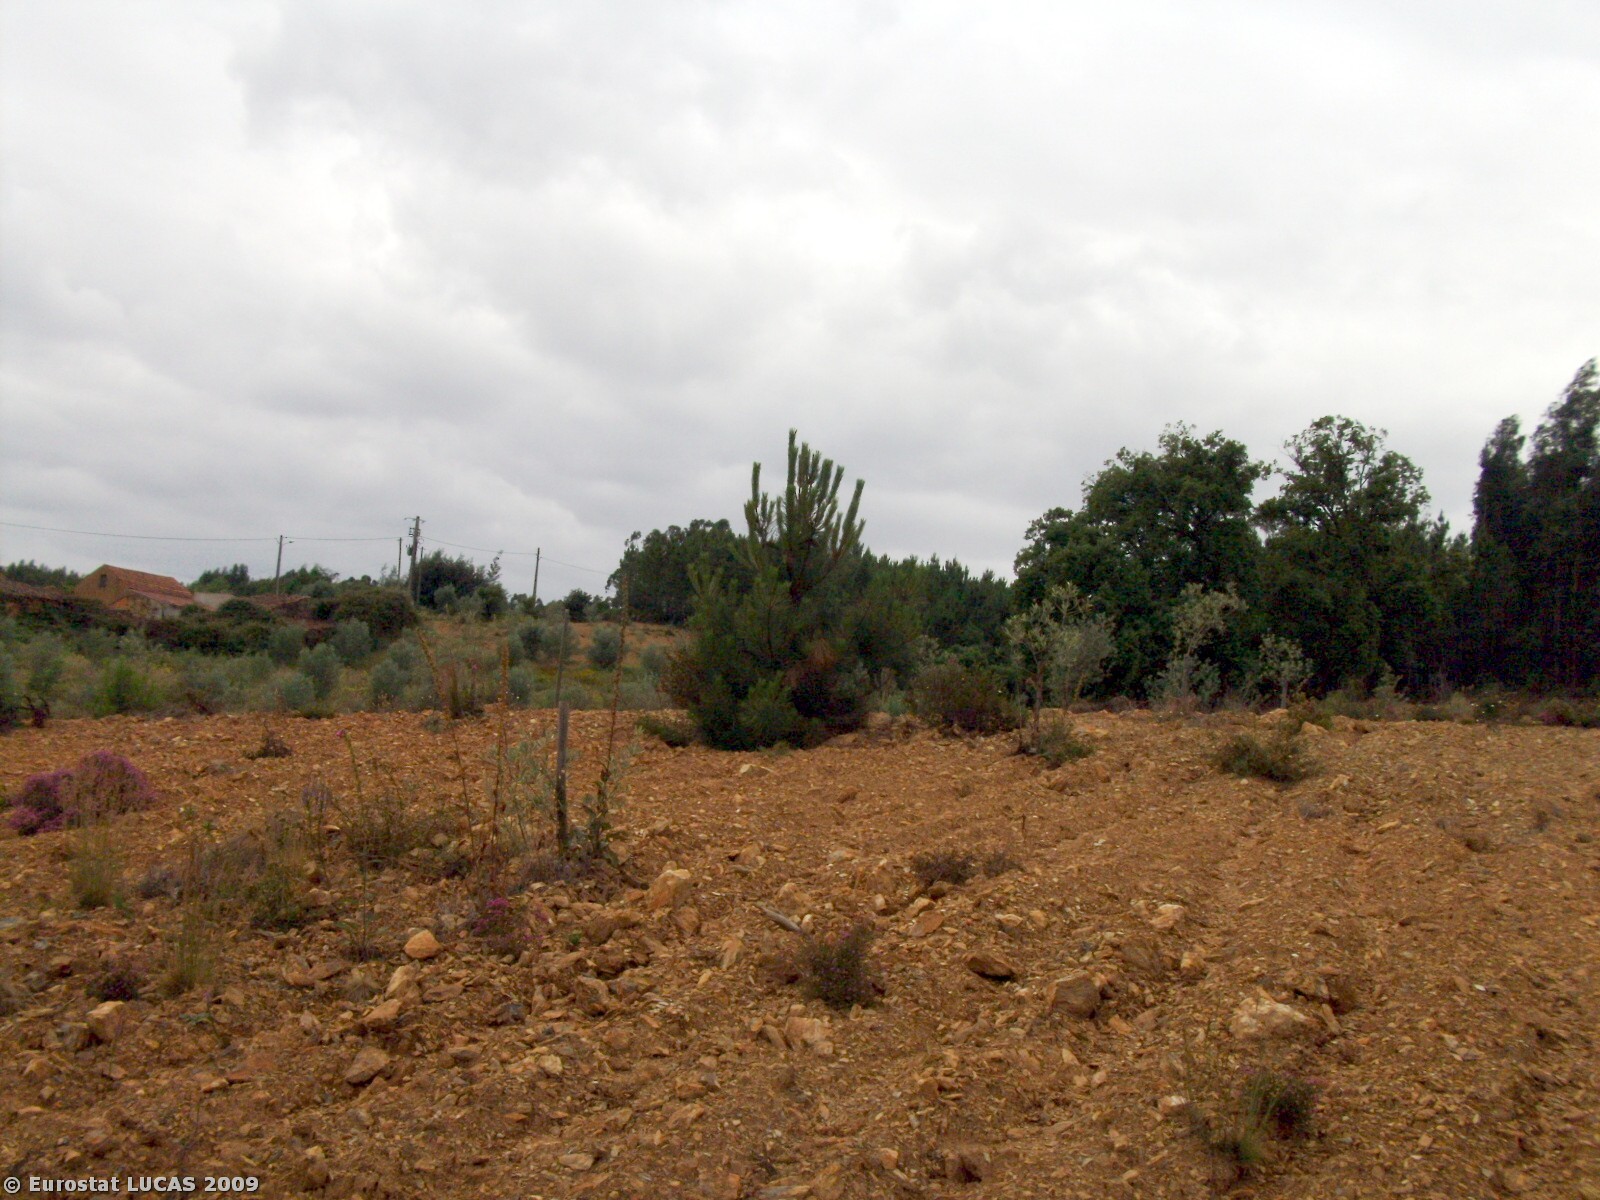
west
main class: Cropland
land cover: Olive groves
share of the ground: < 10 %
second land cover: Bare land
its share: > 75 %
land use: Agriculture (excluding fallow land and kitchen gardens)
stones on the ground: 10 - 25 %
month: June
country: PT
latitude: 39.6775
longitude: -8.2927
